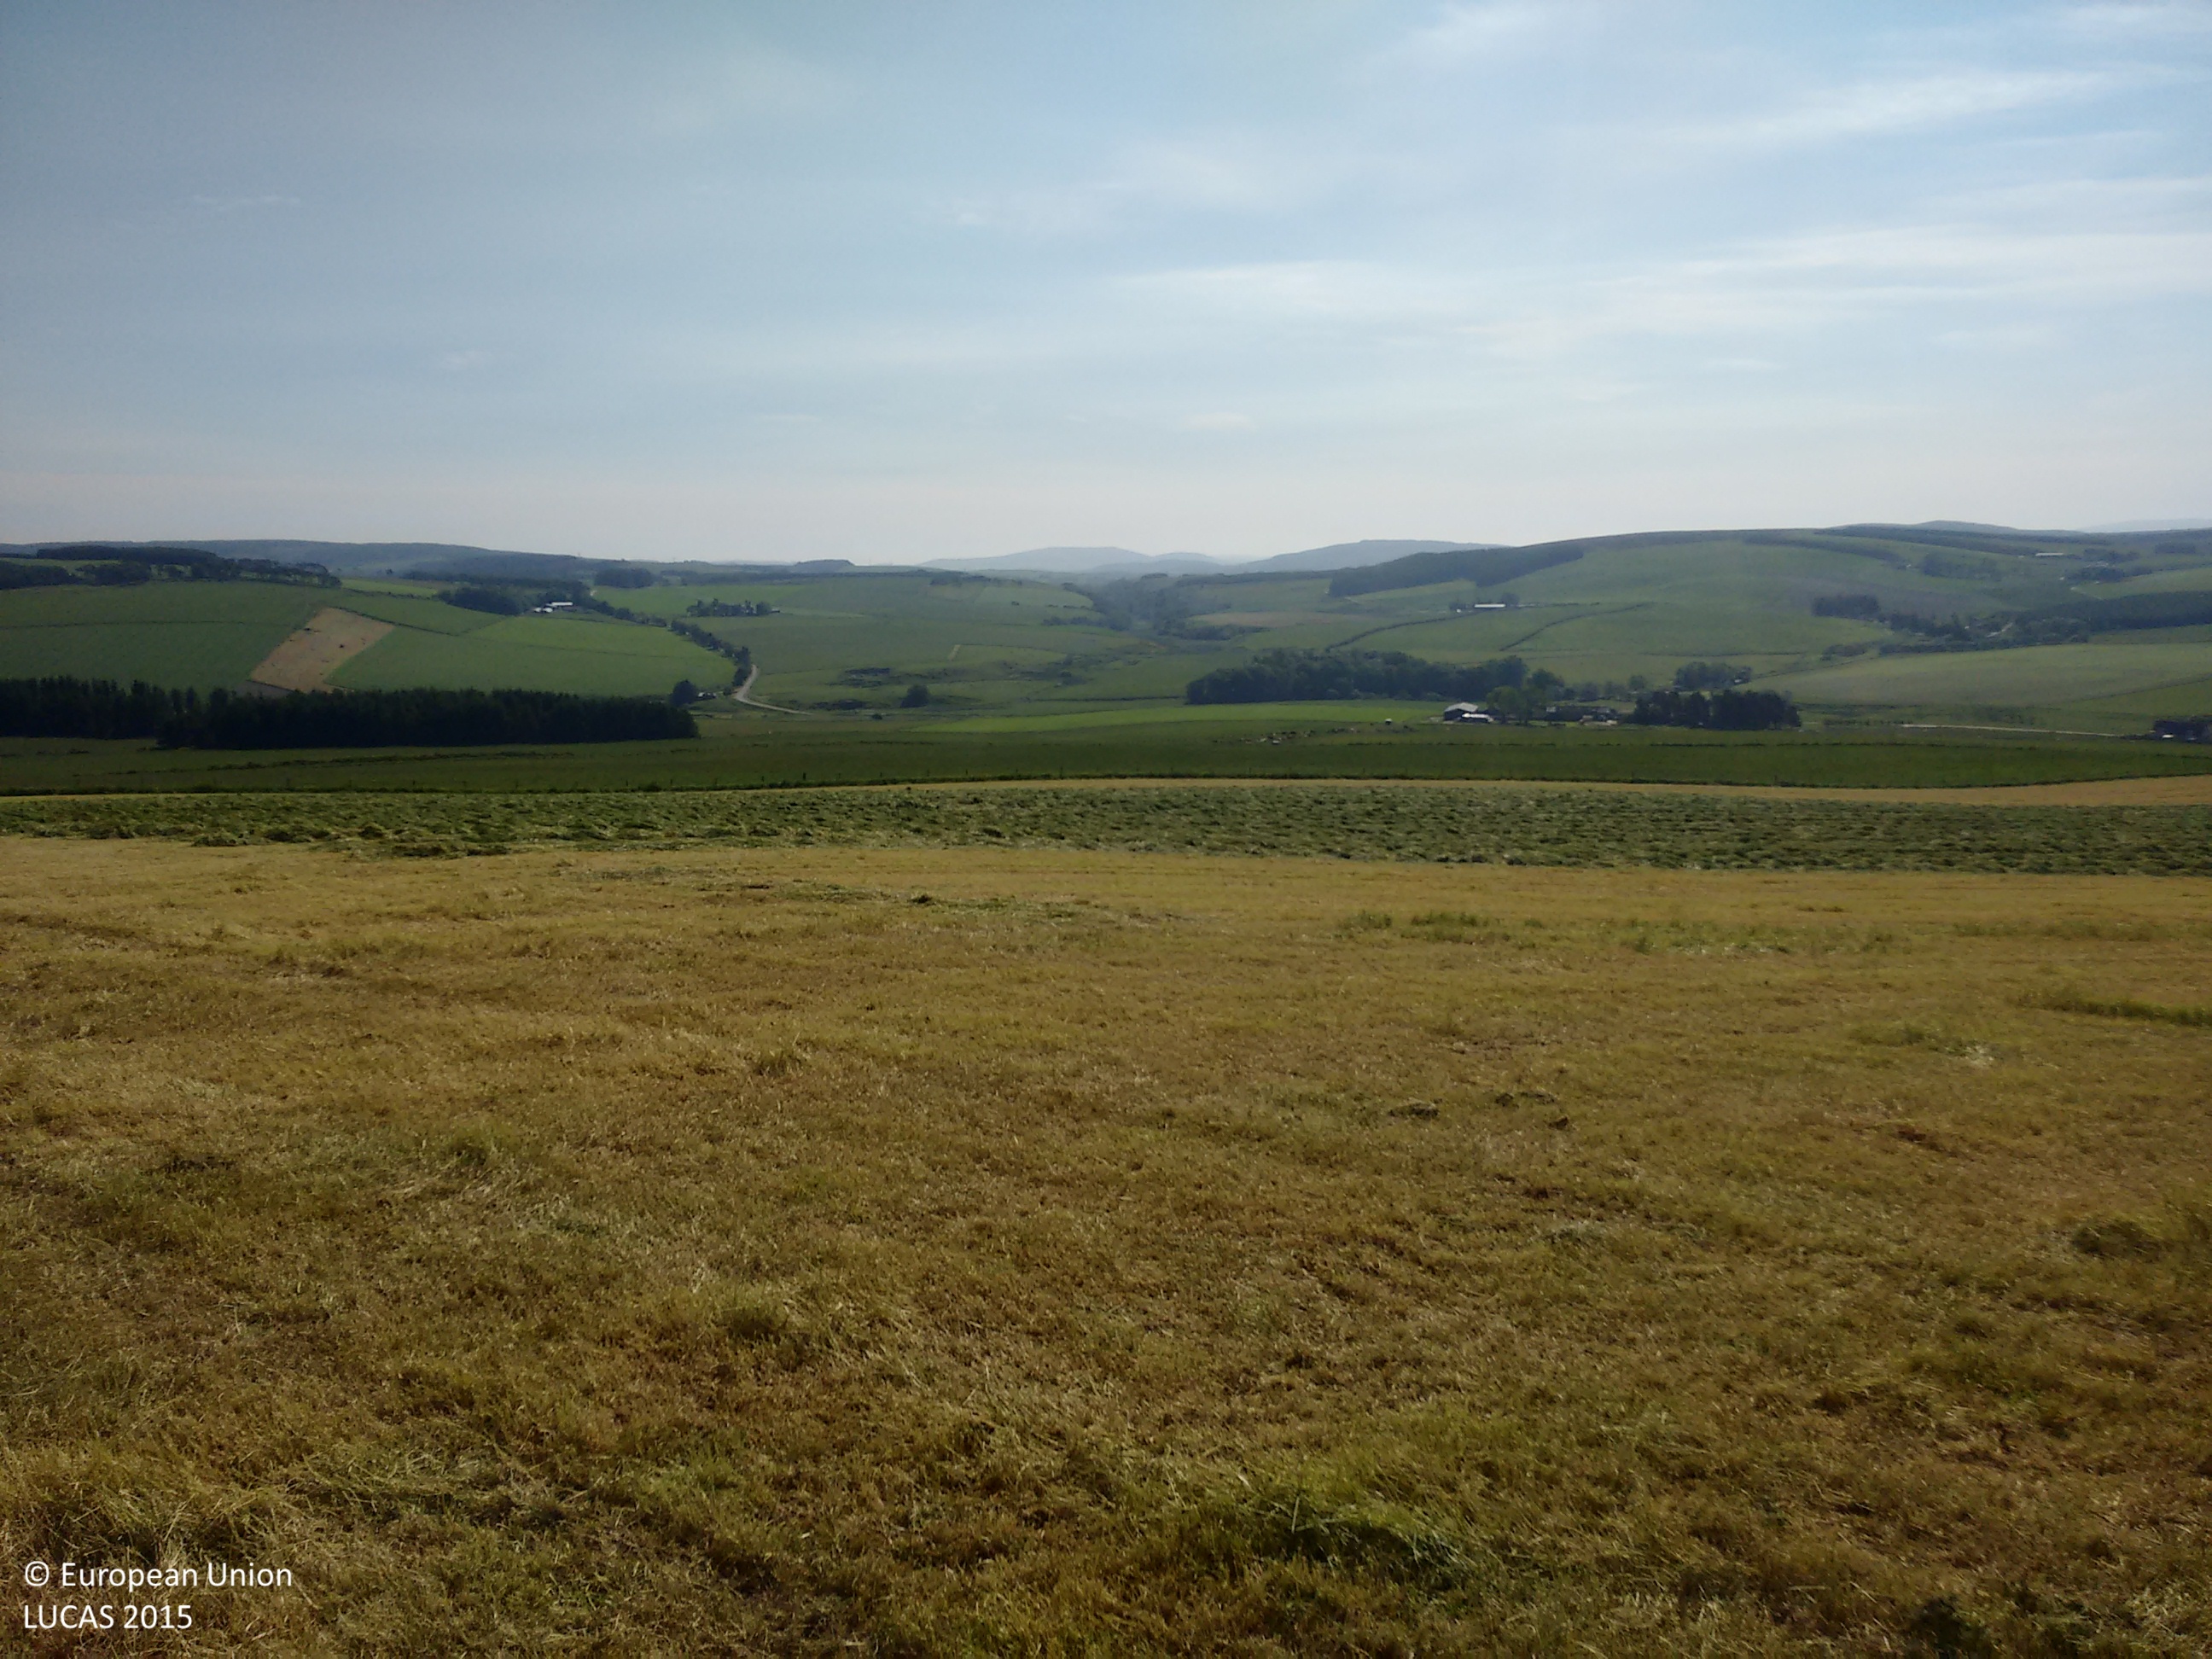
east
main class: Cropland
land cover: Temporary grasslands
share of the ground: > 75 %
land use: Agriculture (excluding fallow land and kitchen gardens)
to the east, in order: Temporary grasslands; Grass margins; Fences; Grass margins; Tracks; Grassland without tree/shrub cover
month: July
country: GB
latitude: 57.4941
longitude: -2.9916
